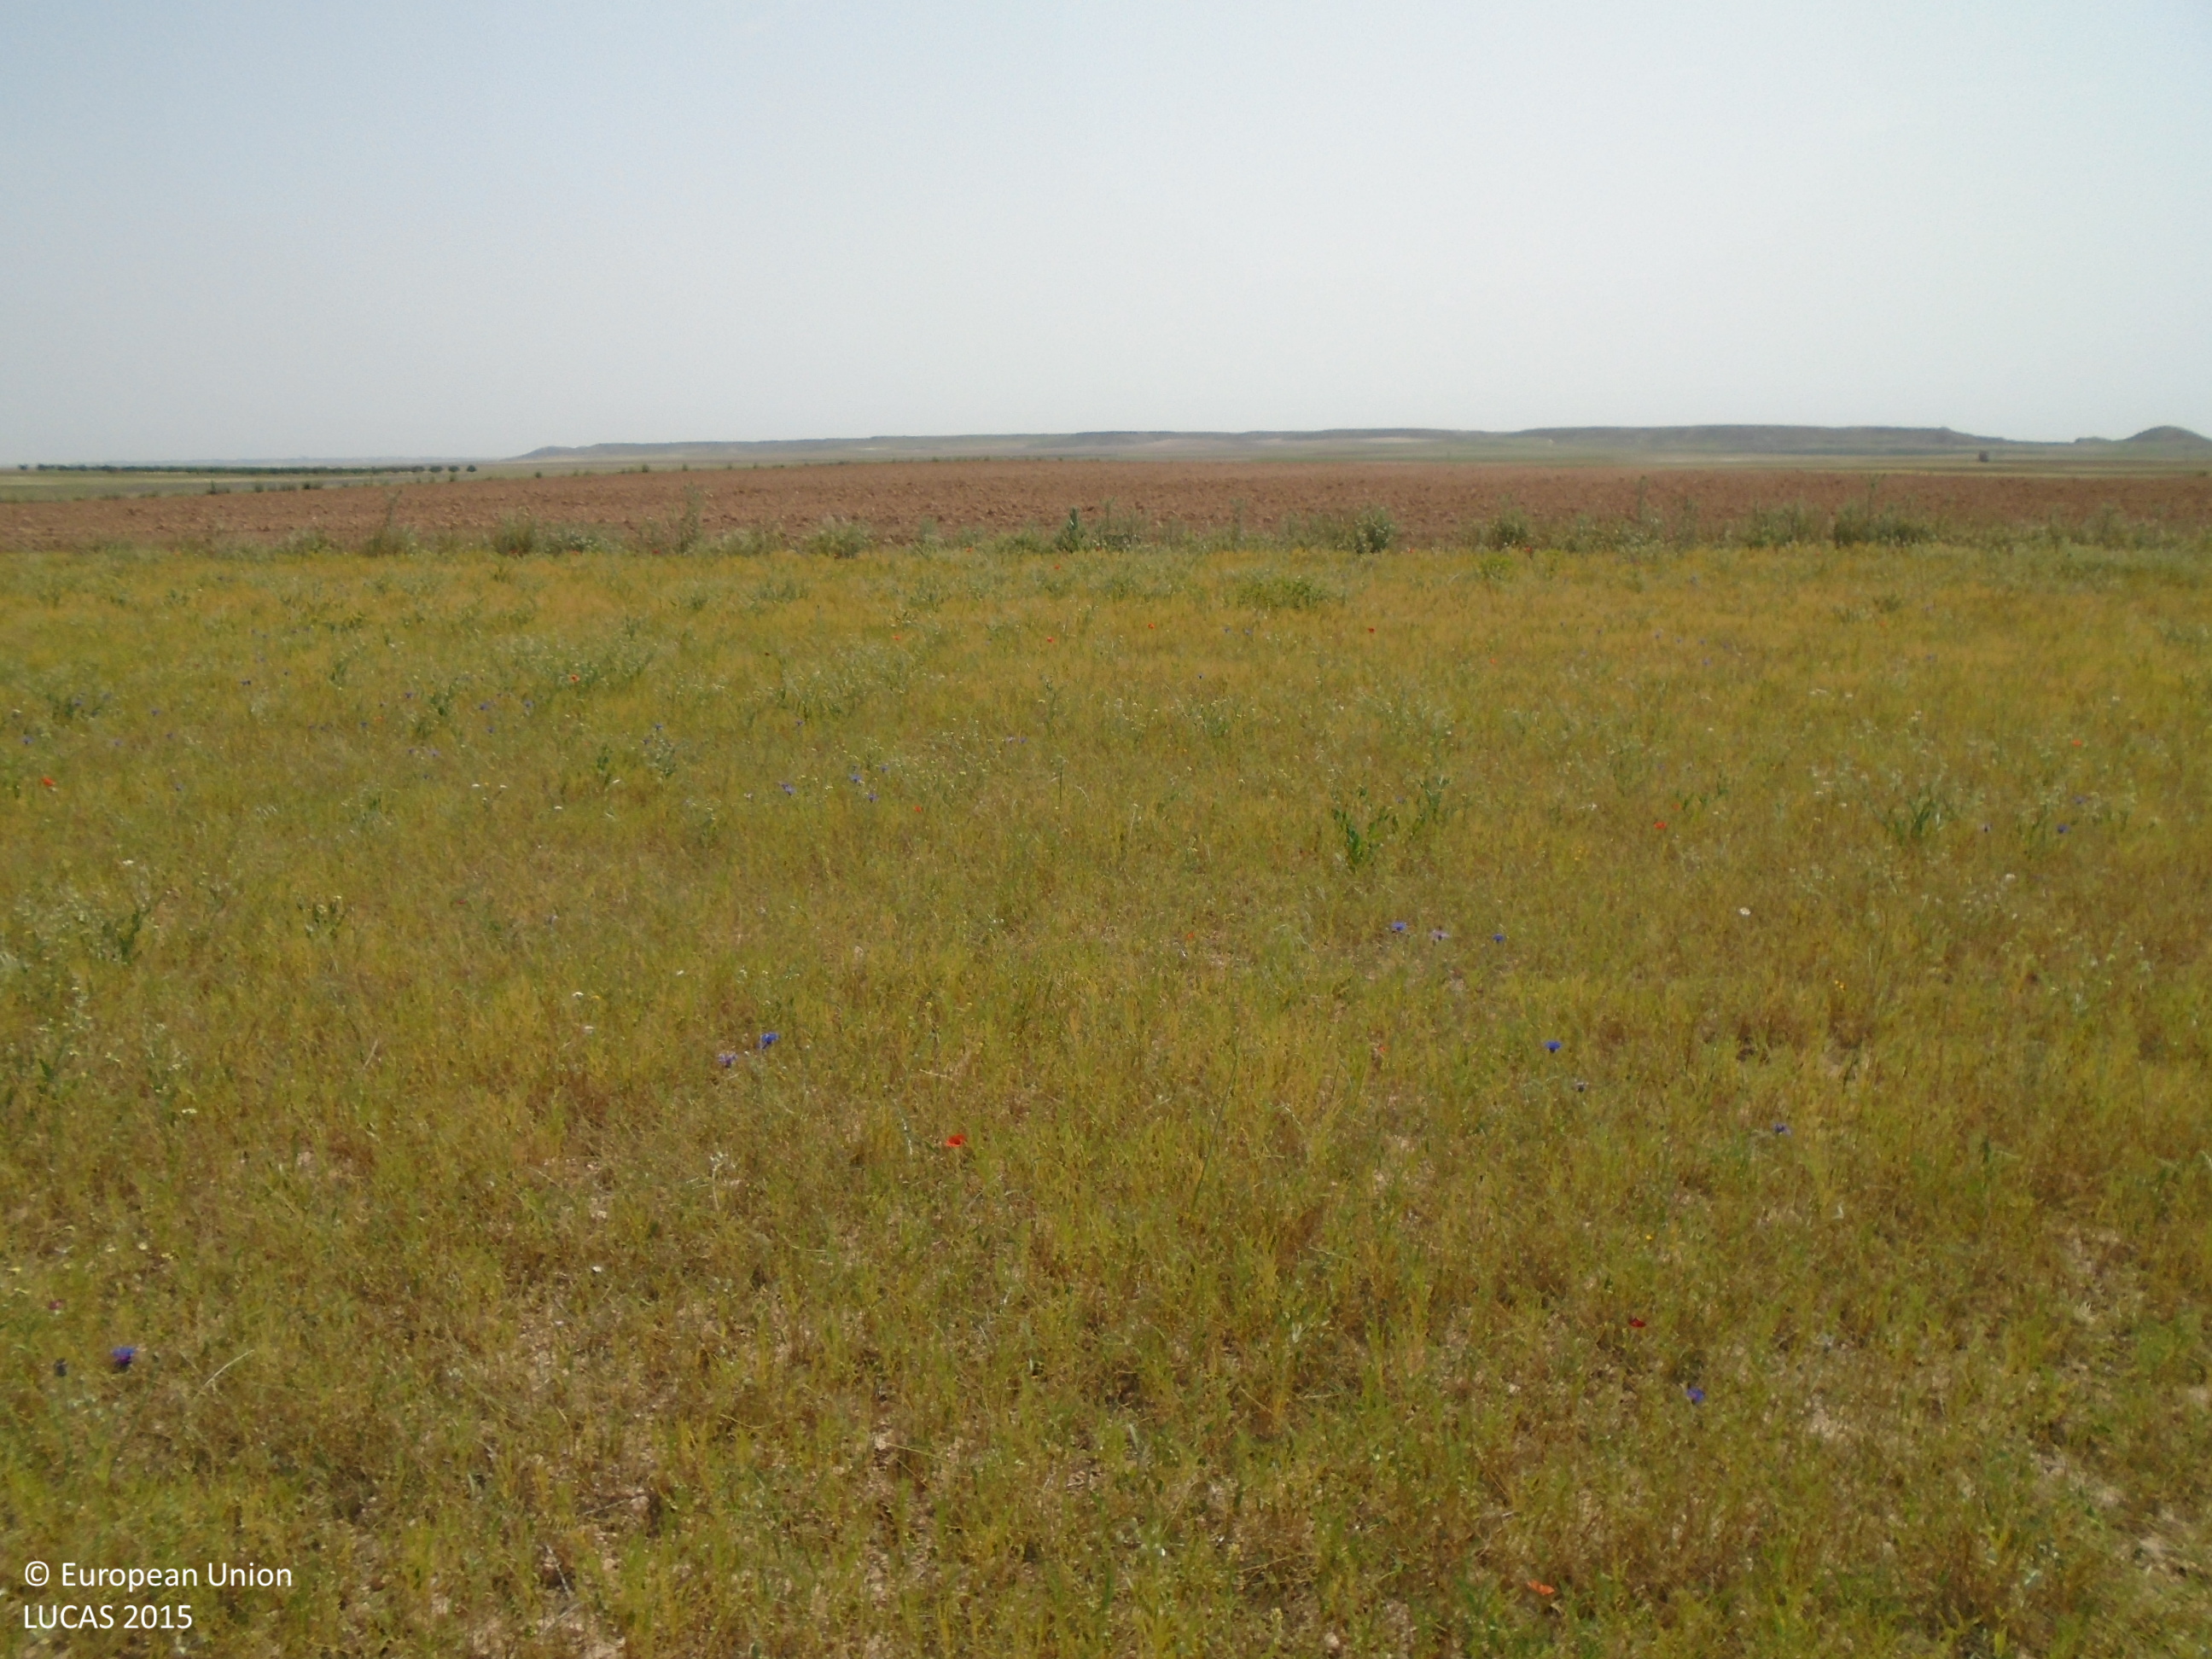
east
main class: Cropland
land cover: Dry pulses
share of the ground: > 75 %
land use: Agriculture (excluding fallow land and kitchen gardens)
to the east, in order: Dry pulses; Grass margins; Other bare soil; Grass margins; Dry pulses
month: May
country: ES
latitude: 39.7339
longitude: -3.6207
